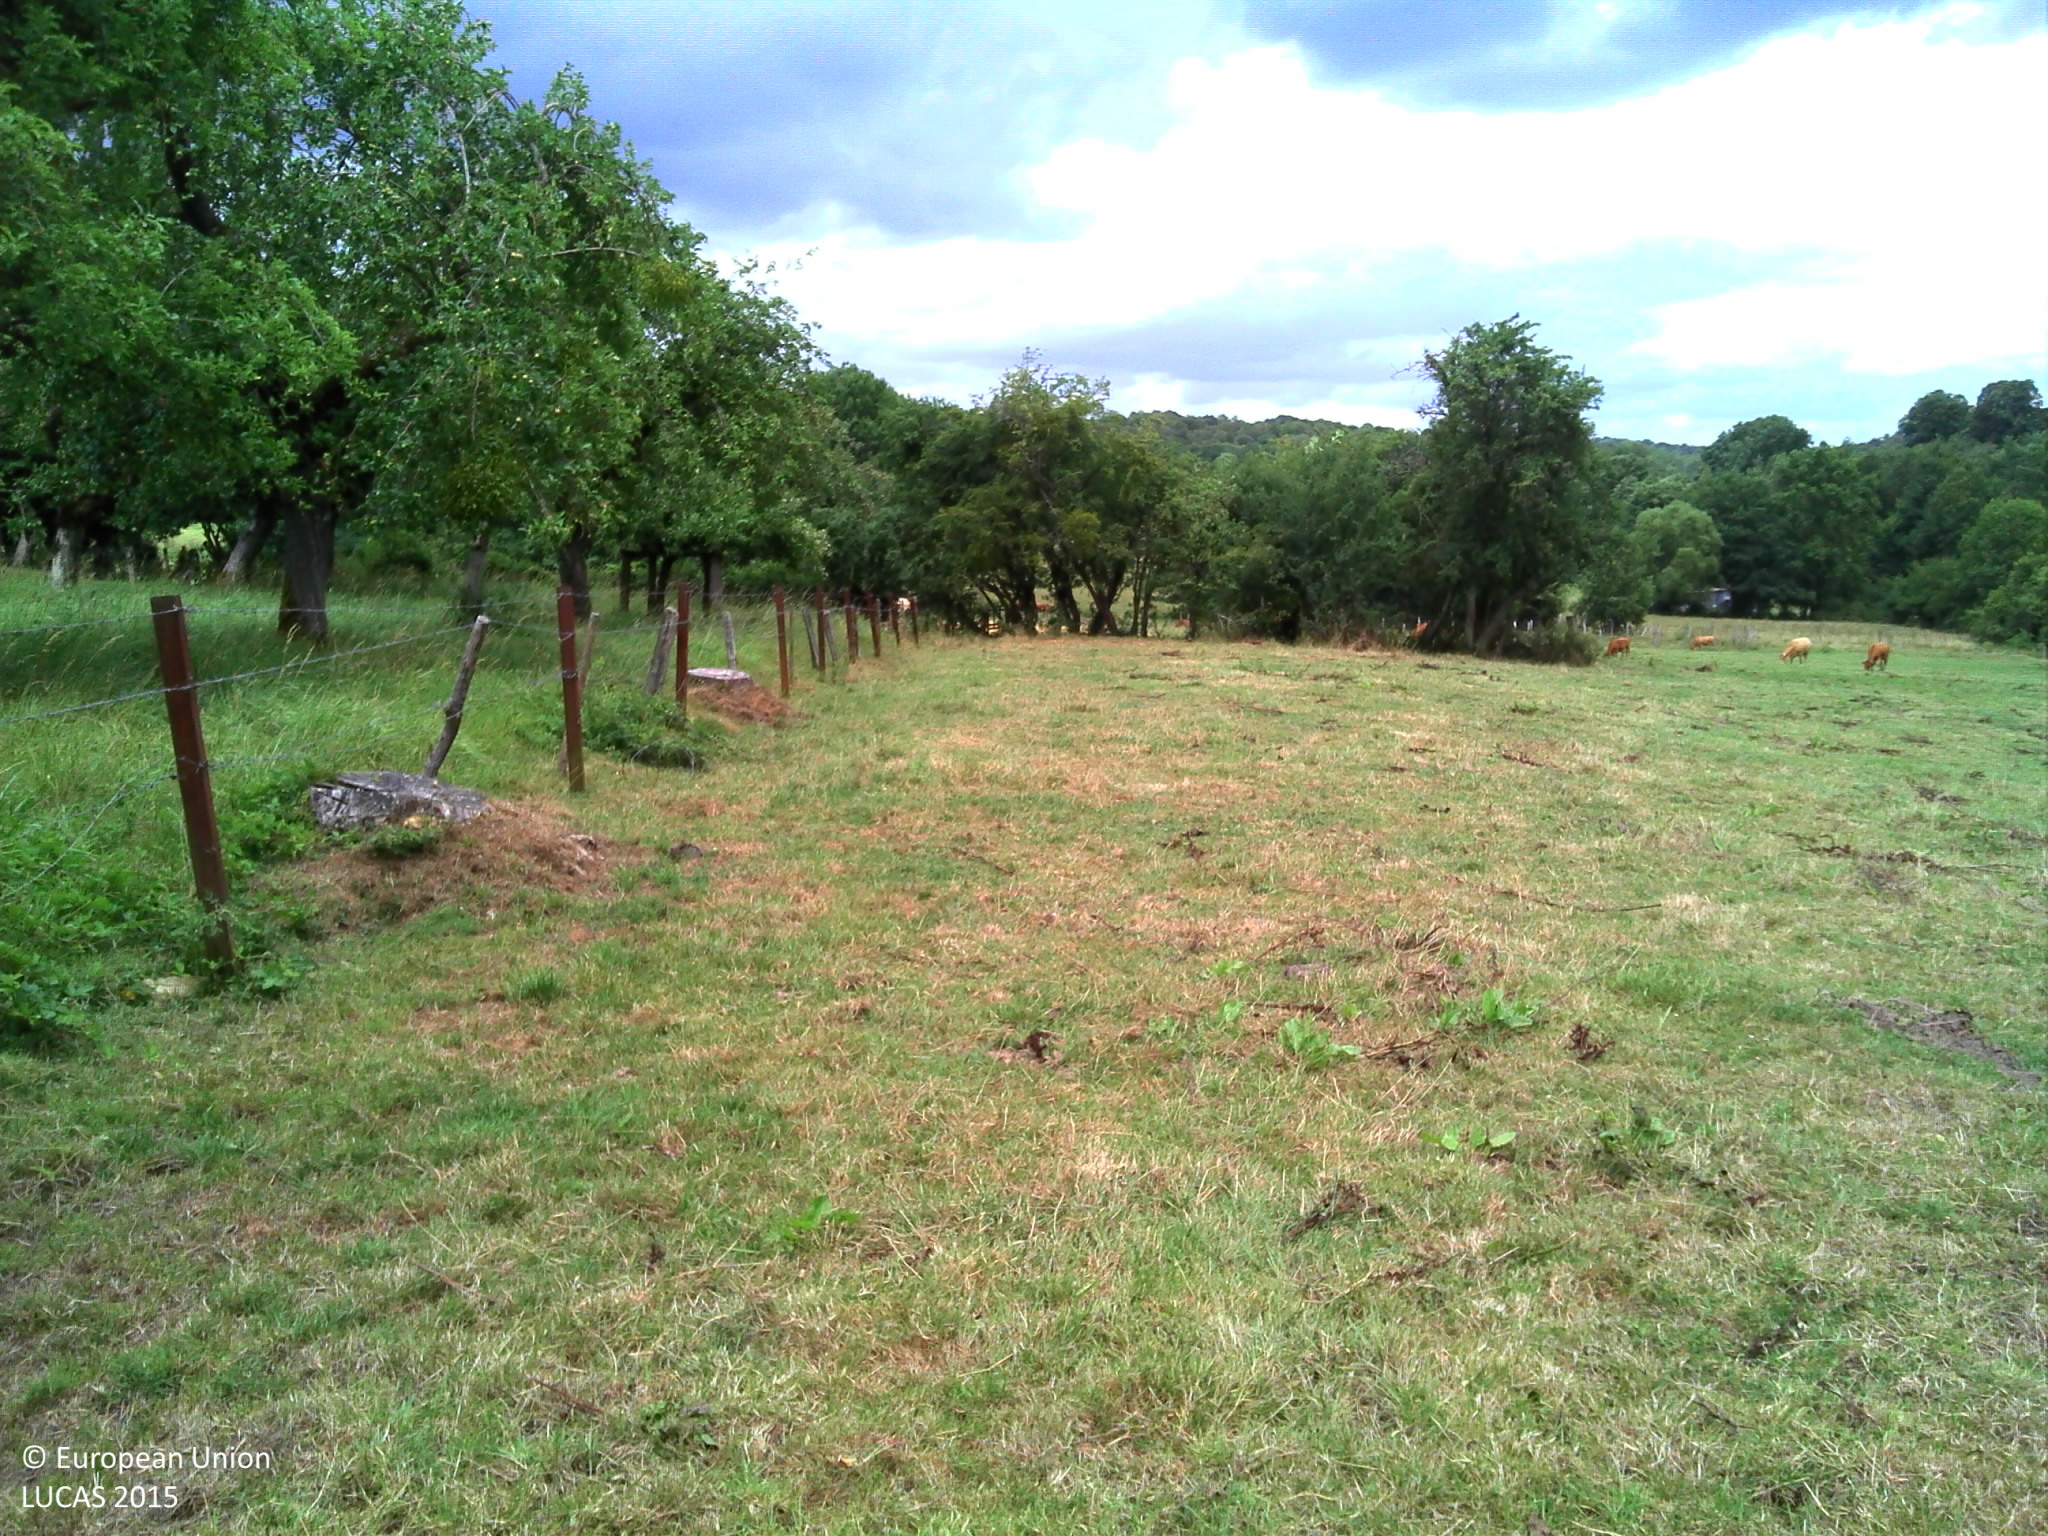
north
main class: Grassland
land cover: Grassland without tree/shrub cover
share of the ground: > 75 %
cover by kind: herbaceous plants 100 %
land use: Agriculture (excluding fallow land and kitchen gardens)
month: July
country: BE
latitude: 49.5808
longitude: 5.6974
